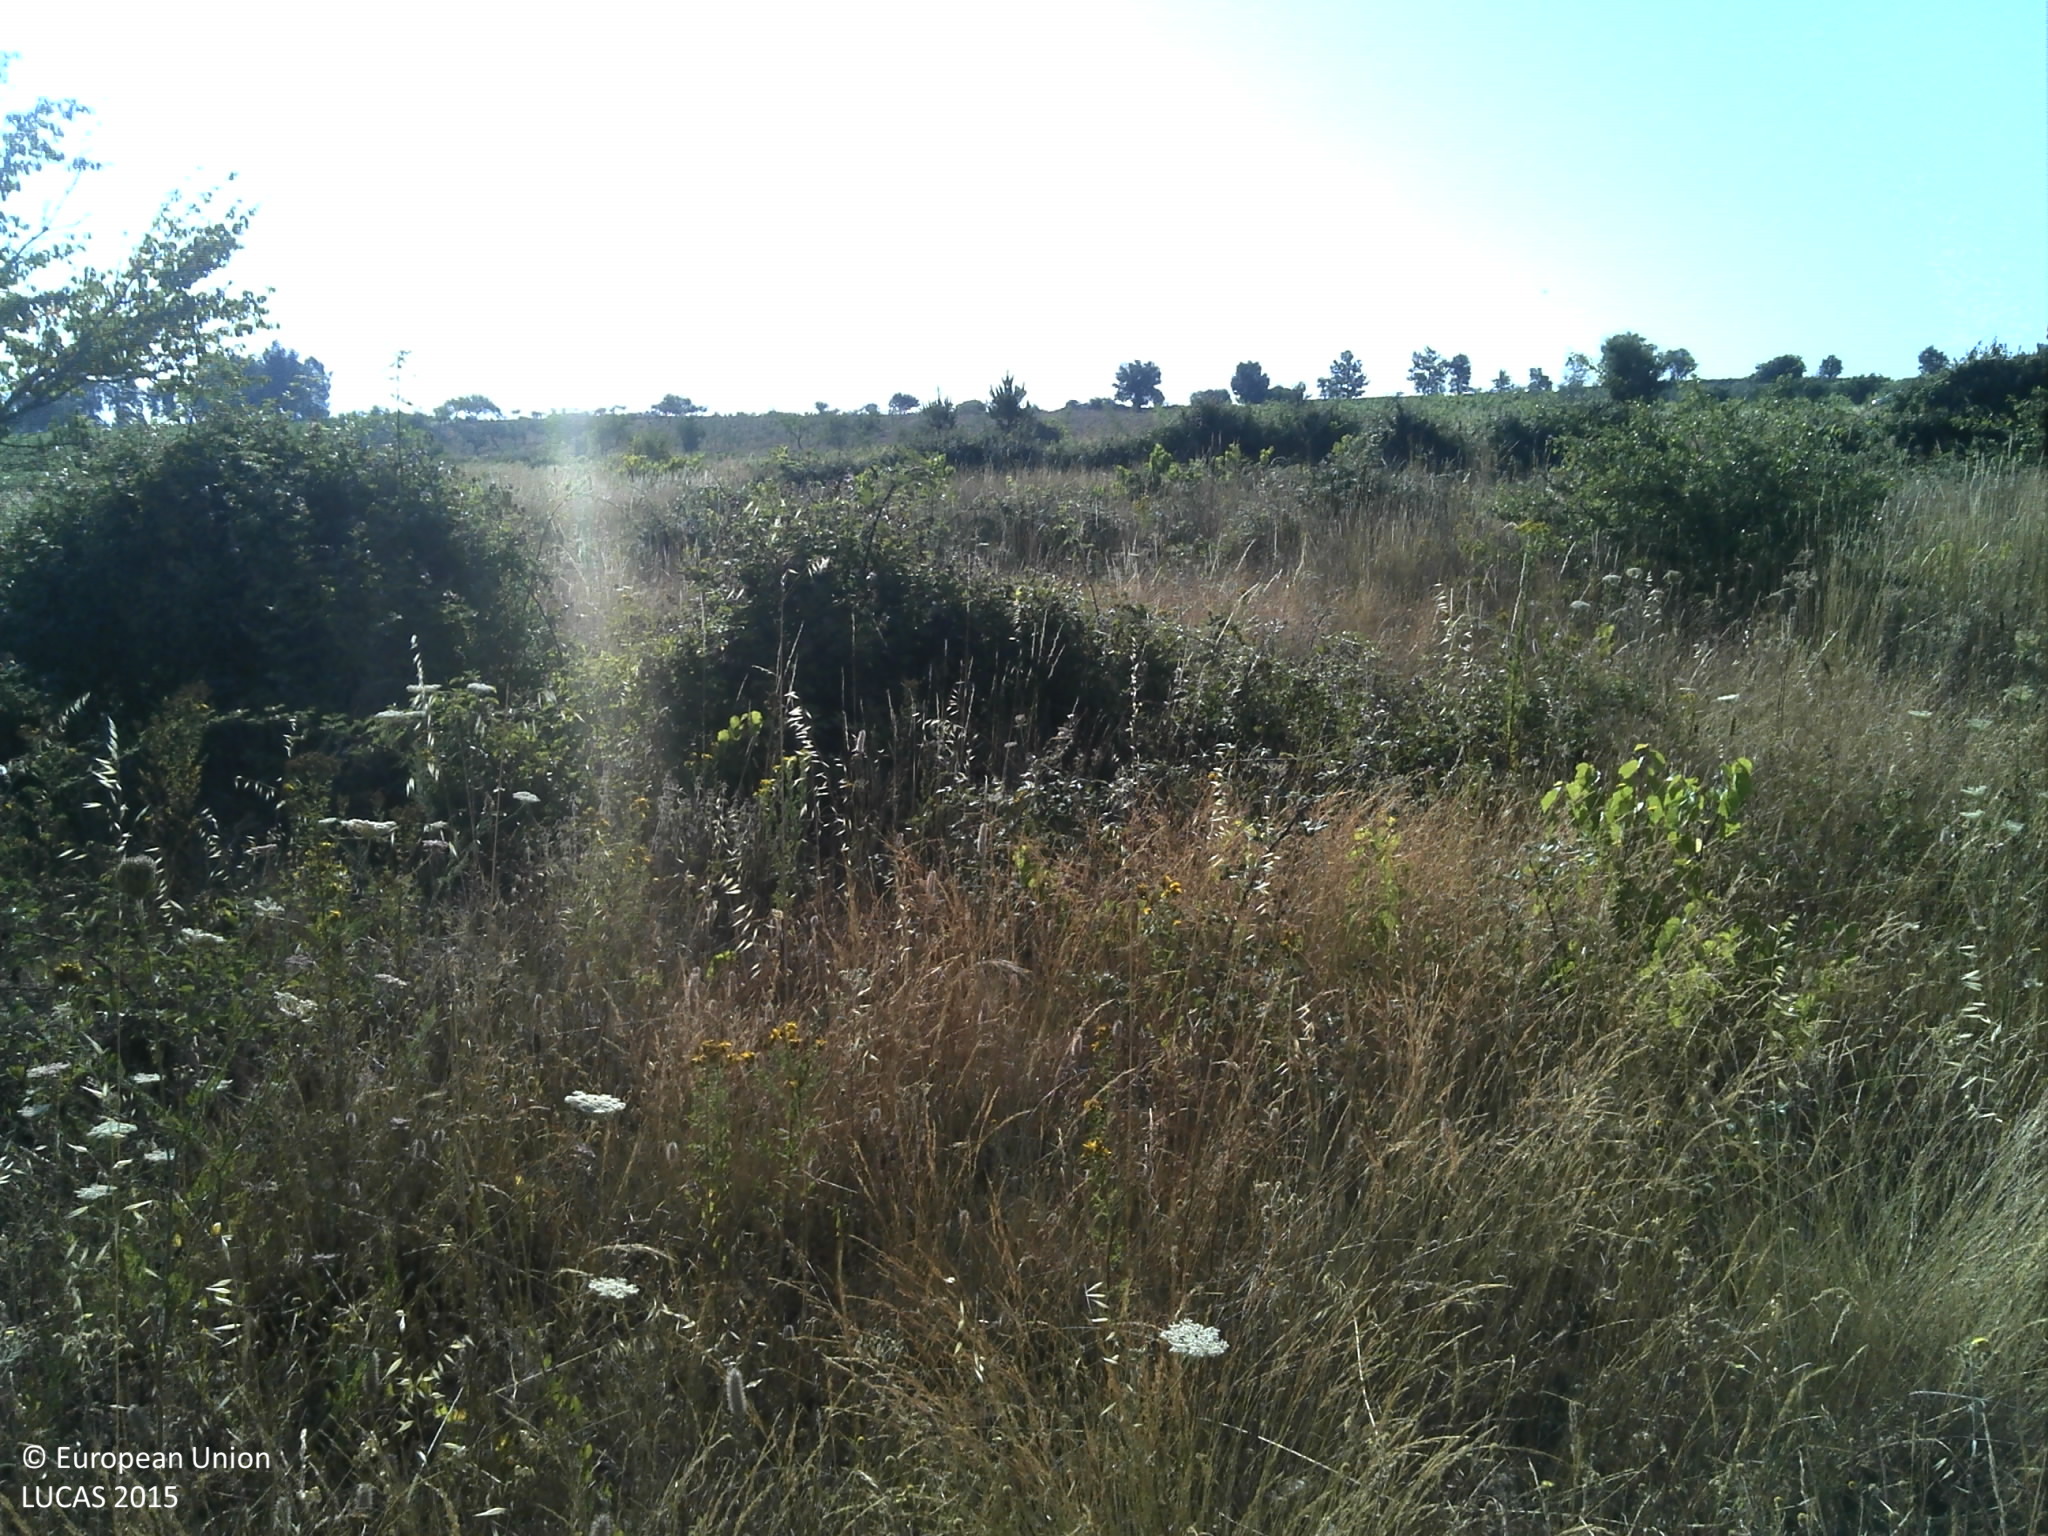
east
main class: Cropland
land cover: Other fruit trees and berries
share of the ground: 10 - 25 %
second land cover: Spontaneously vegetated surfaces
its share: 50 - 75 %
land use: Agriculture (excluding fallow land and kitchen gardens)
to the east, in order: Other fruit trees and berries; Spontaneously vegetated surfaces; Shrubland without tree cover; Vineyards; Shrubland without tree cover; Nuts trees; Cherry fruit; Other fruit trees and berries; Olive groves
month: June
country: PT
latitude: 40.7746
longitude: -7.0352
